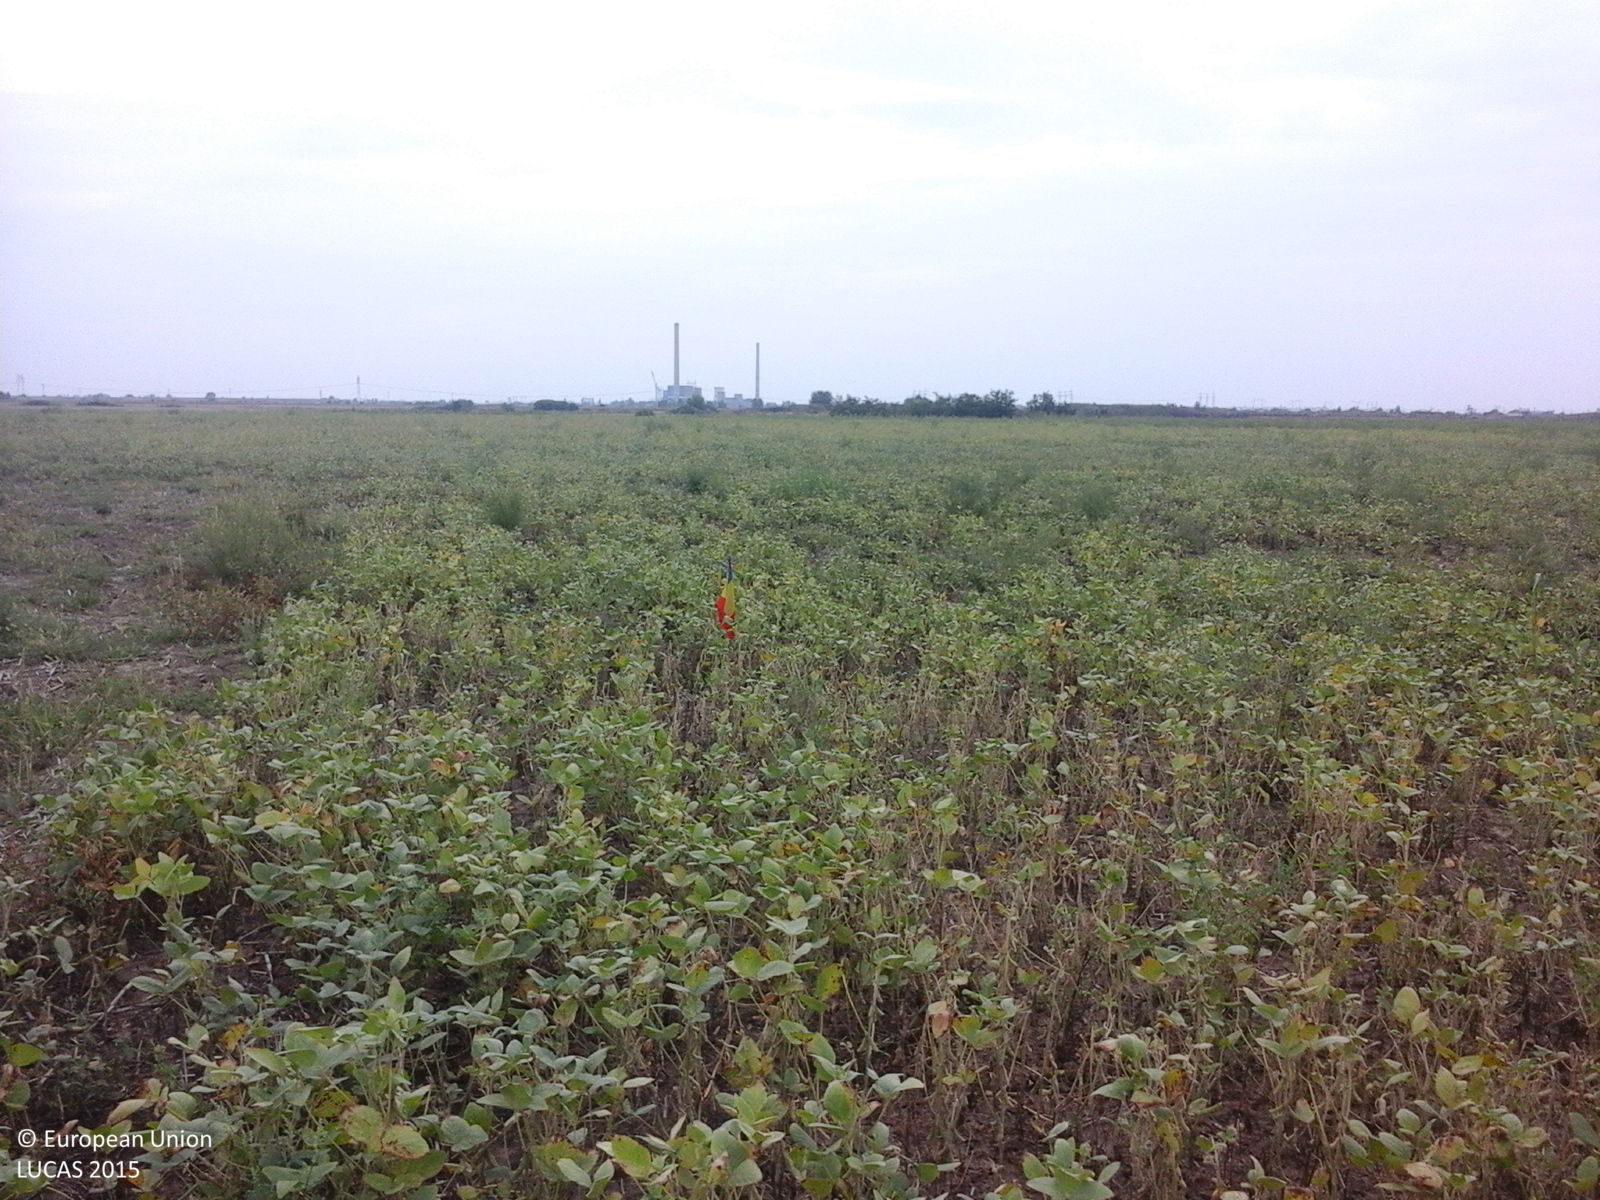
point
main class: Cropland
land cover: Soya
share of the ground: > 75 %
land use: Agriculture (excluding fallow land and kitchen gardens)
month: August
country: RO
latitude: 46.2558
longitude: 21.3334
